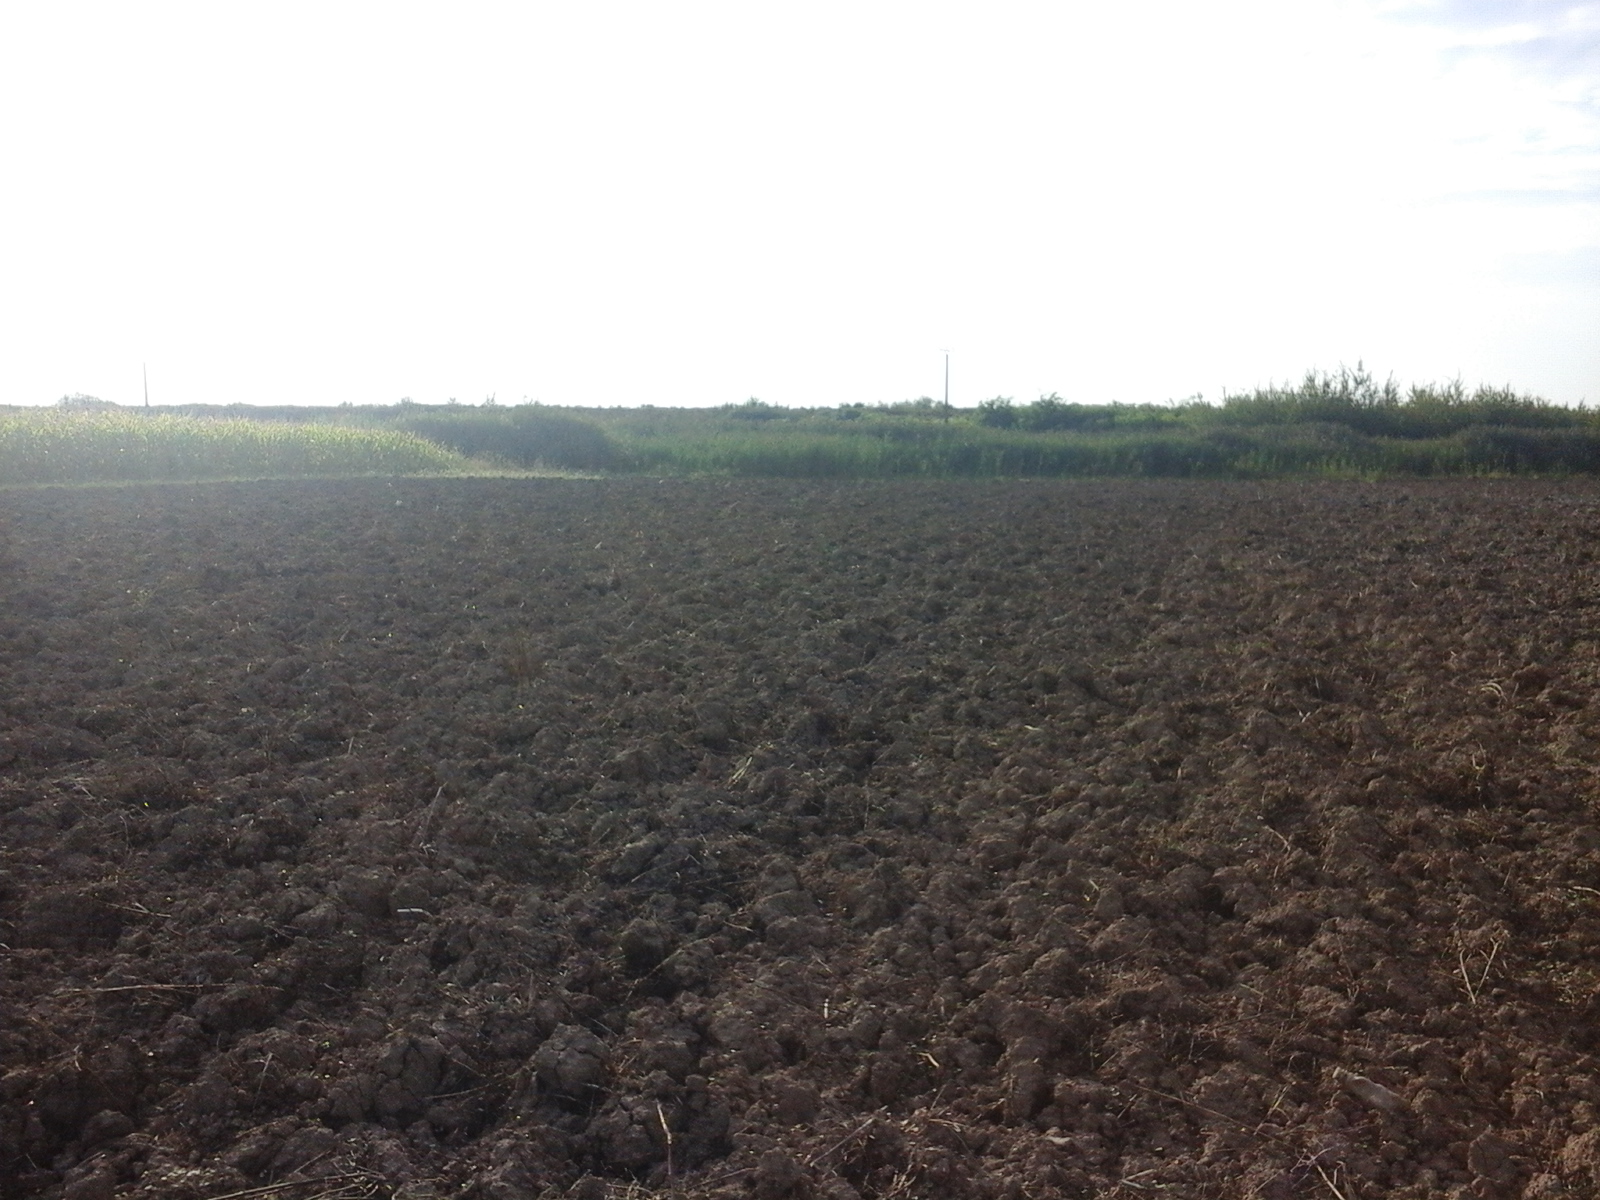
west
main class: Cropland
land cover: Rape and turnip rape
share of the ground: < 10 %
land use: Agriculture (excluding fallow land and kitchen gardens)
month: August
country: RO
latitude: 46.6628
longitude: 21.6063
